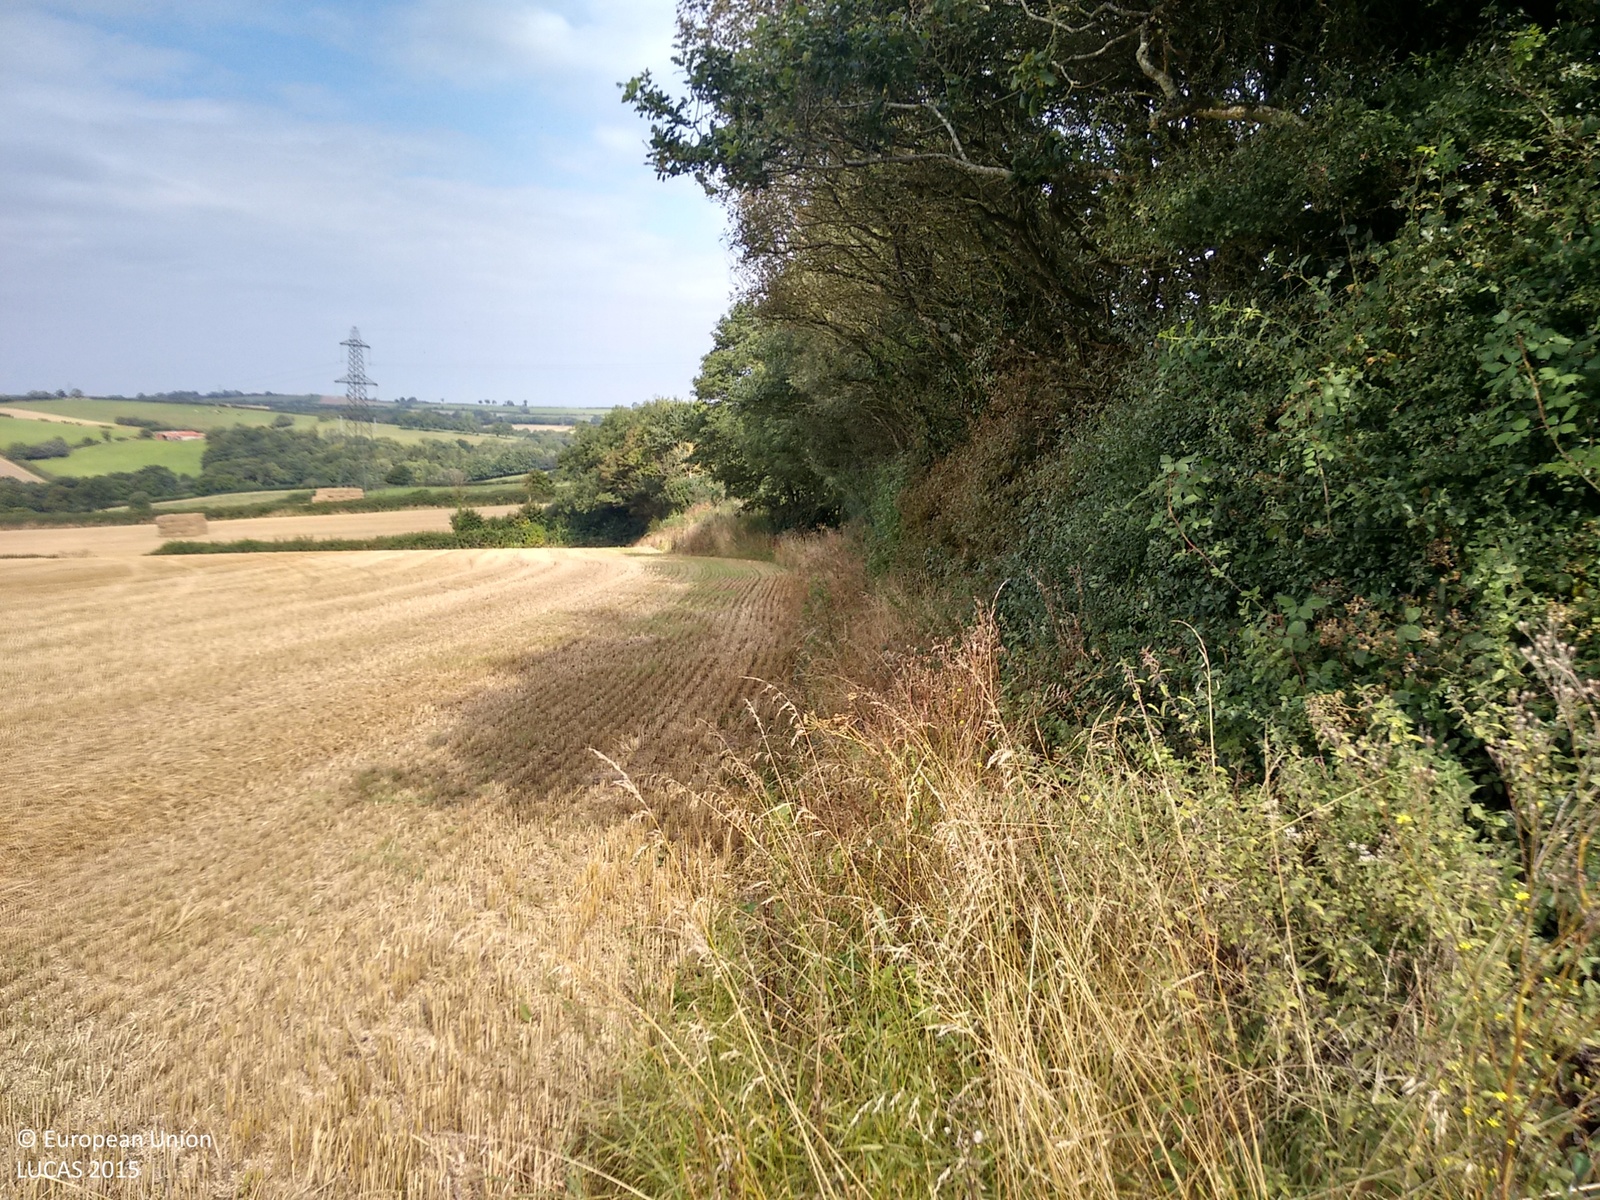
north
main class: Cropland
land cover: Barley
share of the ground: > 75 %
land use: Agriculture (excluding fallow land and kitchen gardens)
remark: Harvested field
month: September
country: GB
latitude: 51.0207
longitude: -3.9355
